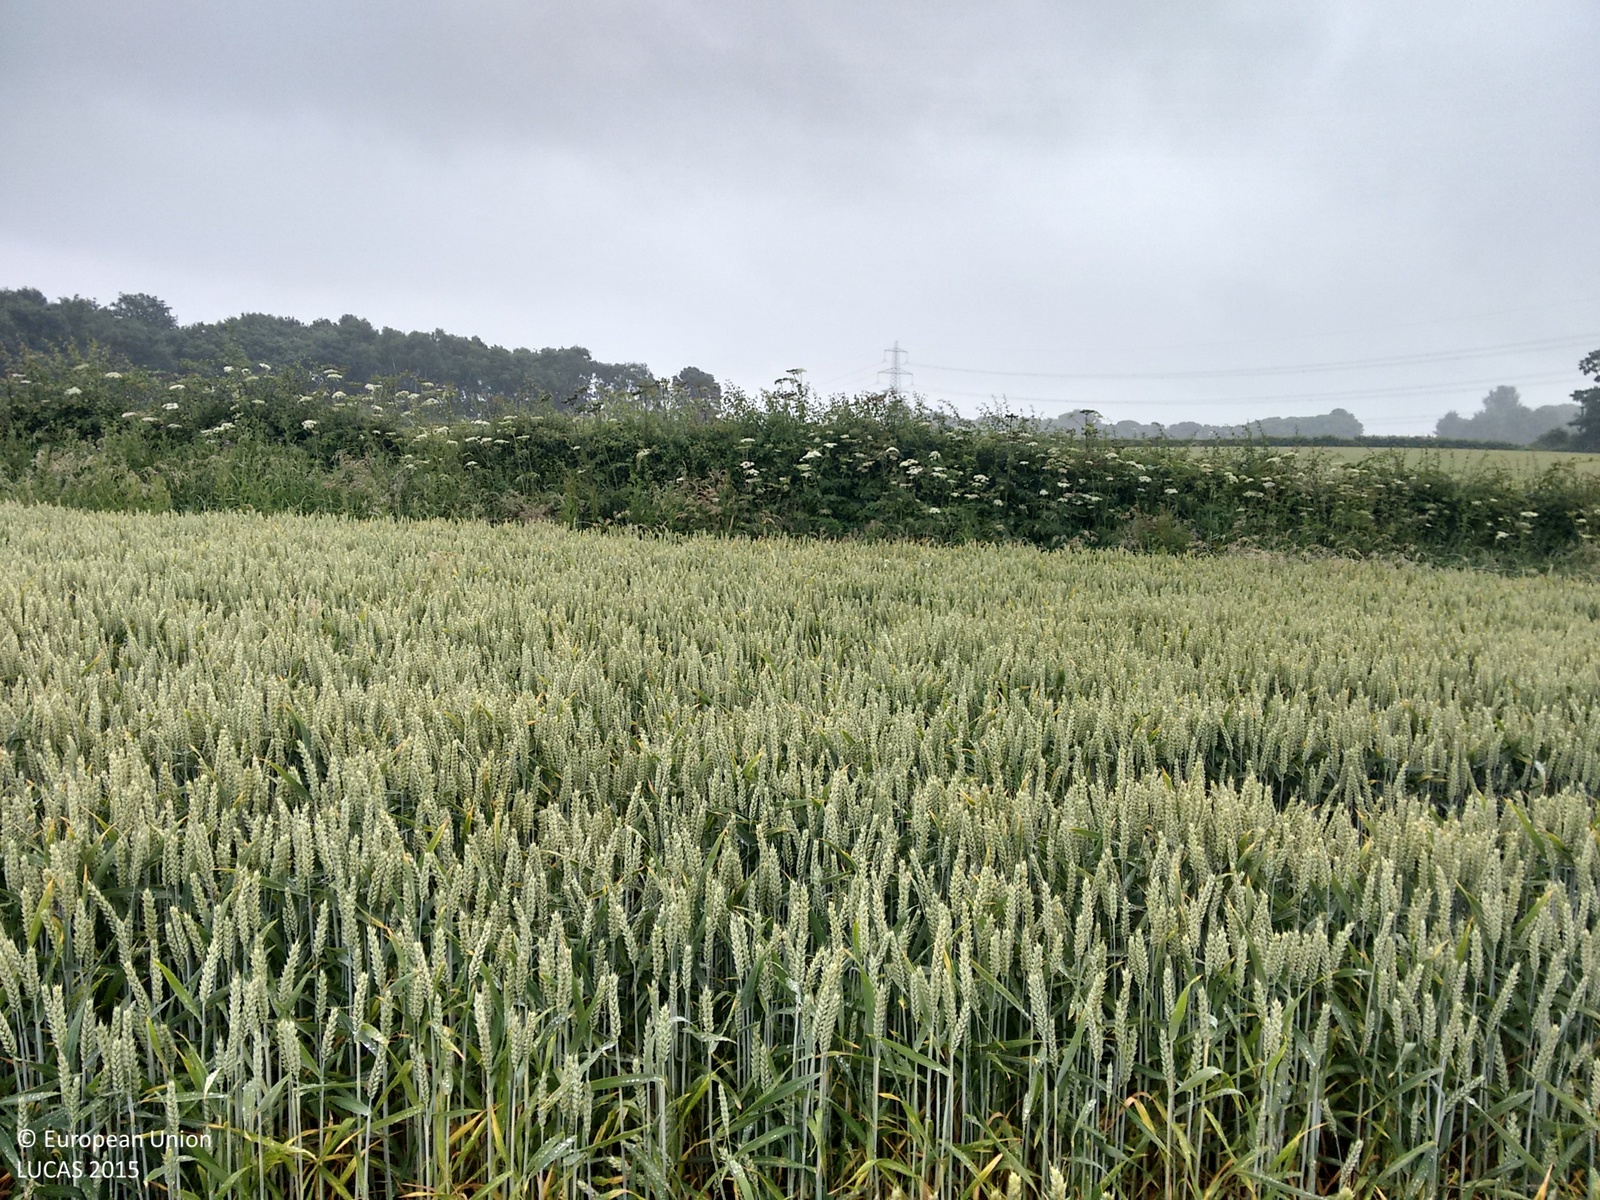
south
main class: Cropland
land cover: Common wheat
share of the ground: > 75 %
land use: Agriculture (excluding fallow land and kitchen gardens)
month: July
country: GB
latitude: 53.4483
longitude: -2.7938
